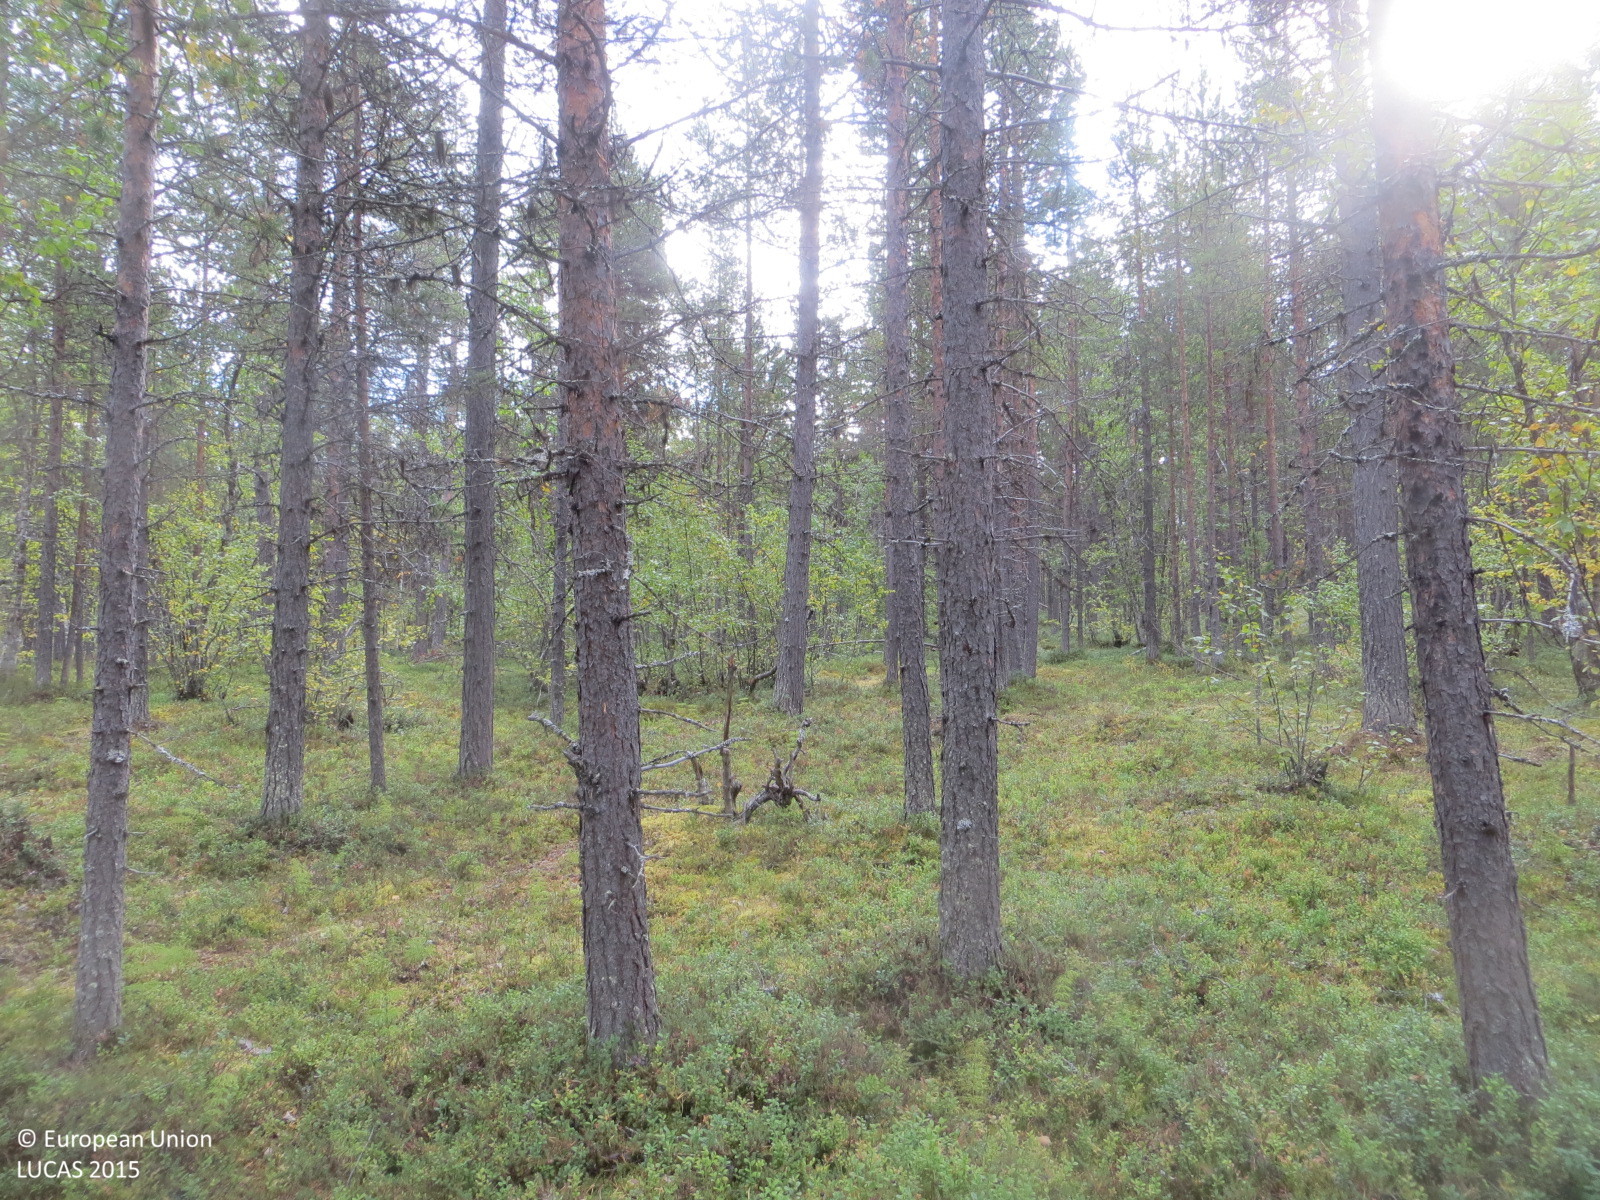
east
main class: Woodland
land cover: Pine dominated mixed woodland
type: boreal forest
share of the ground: 50 - 75 %
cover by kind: shrubs 50 %, coniferous forest trees 35 %, broadleaved forest trees 15 %
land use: Forestry
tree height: > 5 m
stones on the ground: < 10 %
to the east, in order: Pine dominated mixed woodland; Pine dominated coniferous woodland; Tracks; Pine dominated coniferous woodland
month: September
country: FI
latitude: 68.3580
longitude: 24.1288
